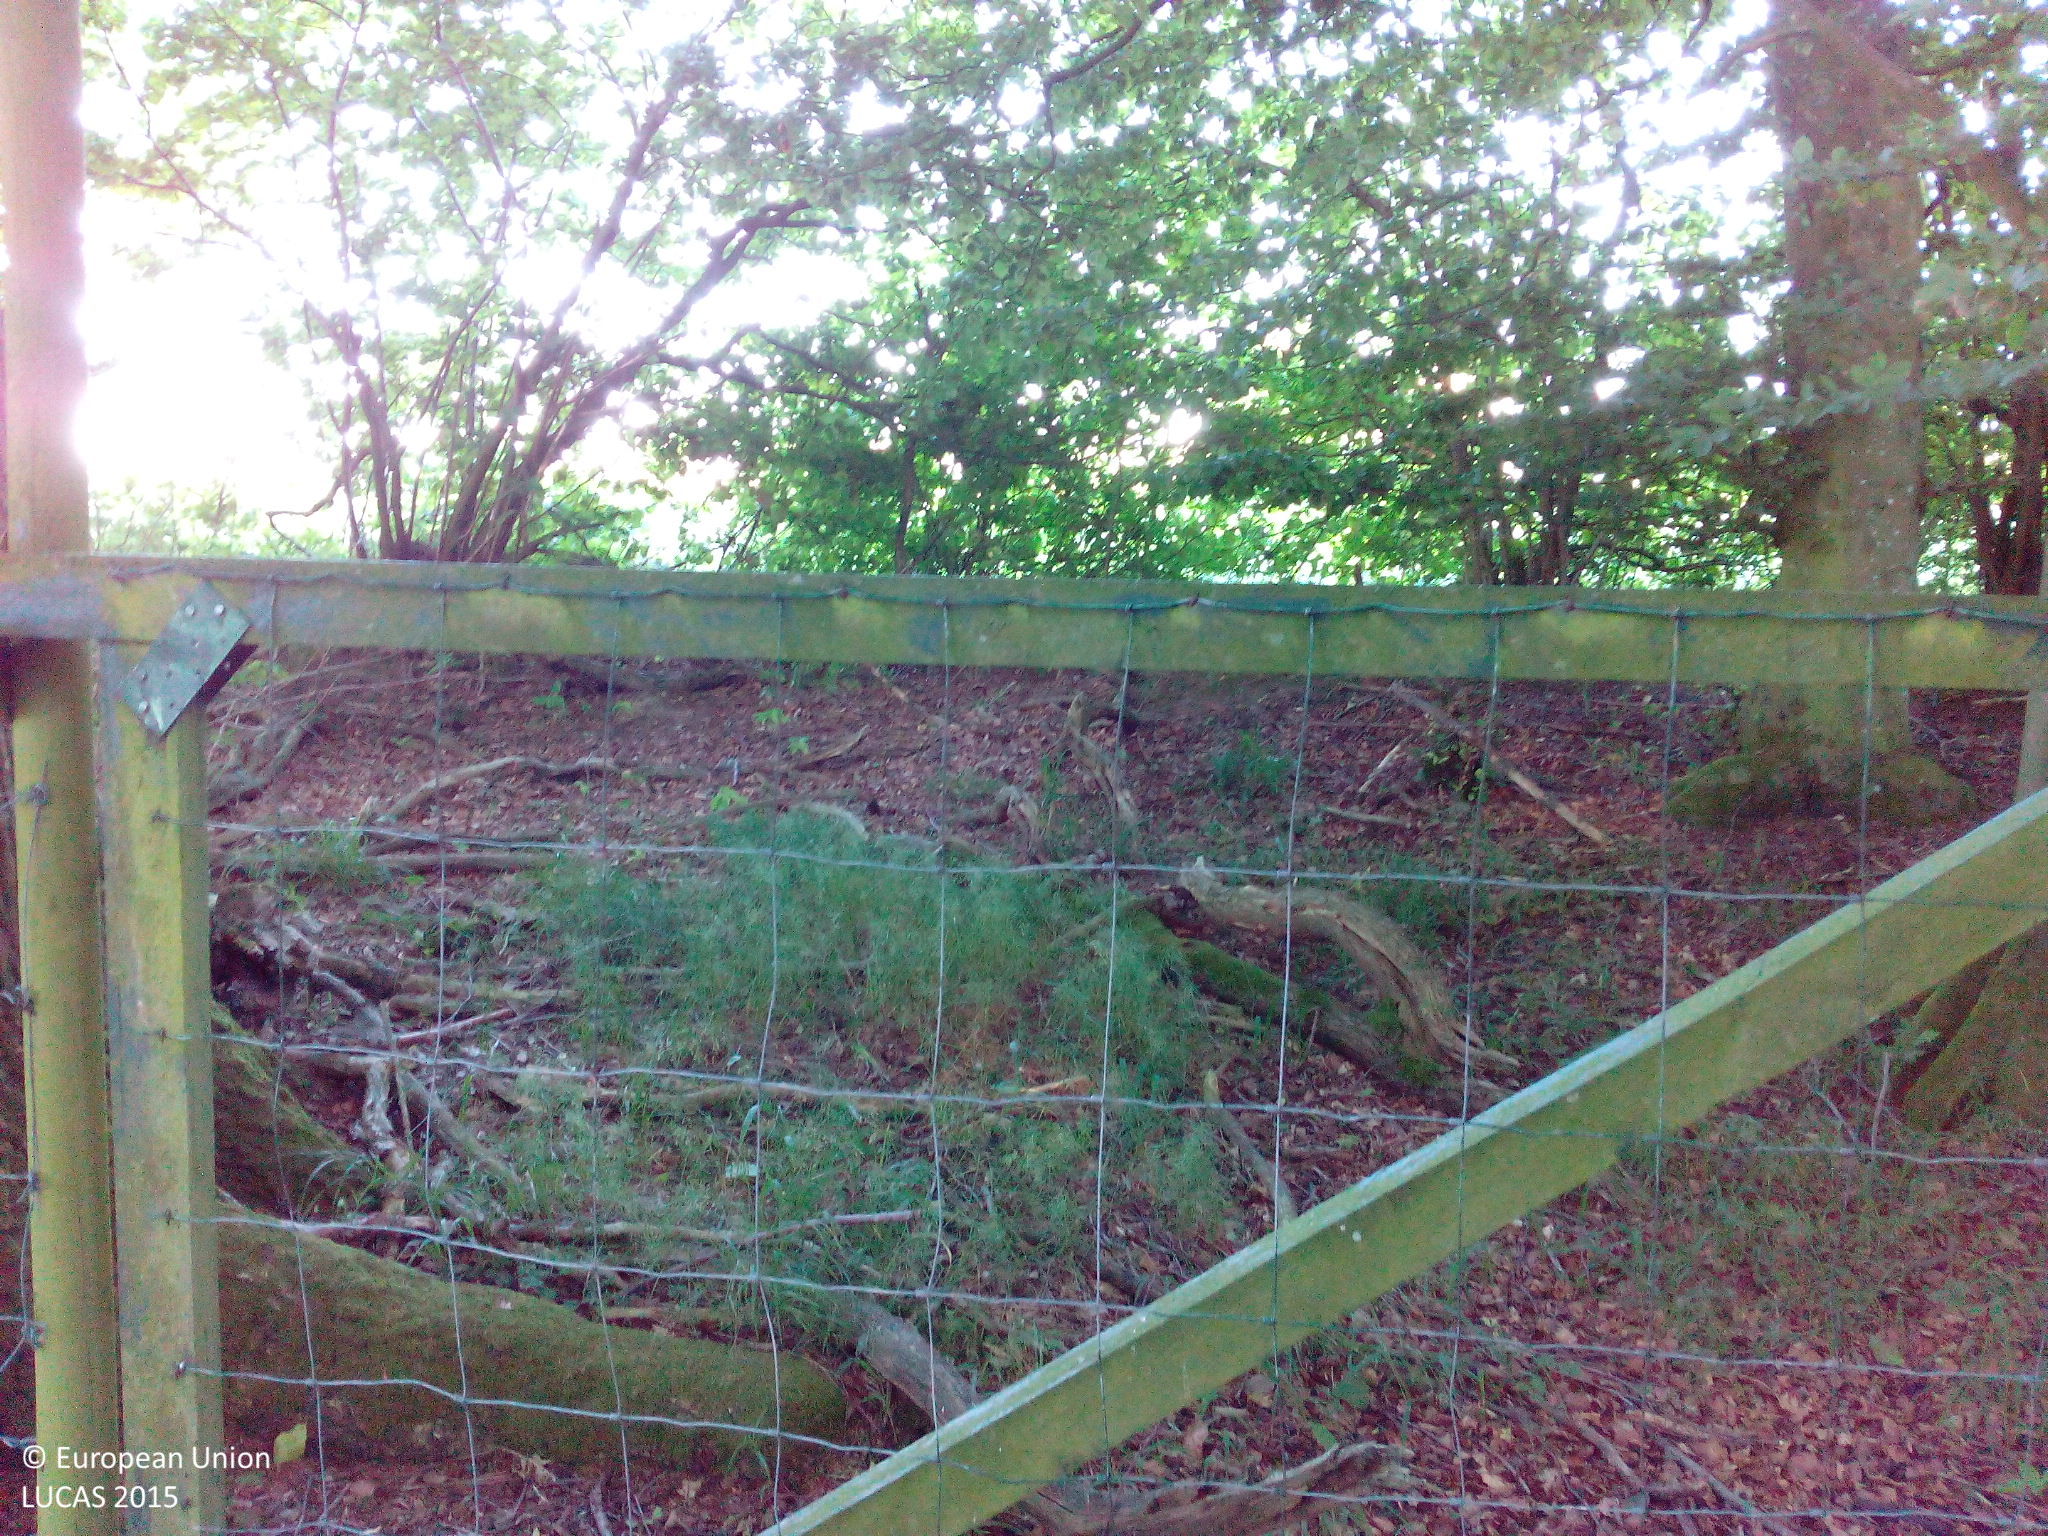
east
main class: Woodland
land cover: Broadleaved woodland
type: beech forest
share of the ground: > 75 %
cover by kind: broadleaved forest trees 90 %, herbaceous plants 10 %
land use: Forestry
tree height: > 5 m
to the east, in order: Broadleaved woodland; Fences; Broadleaved woodland; Grass margins; Common wheat
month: July
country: DK
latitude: 55.2008
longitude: 12.0253
